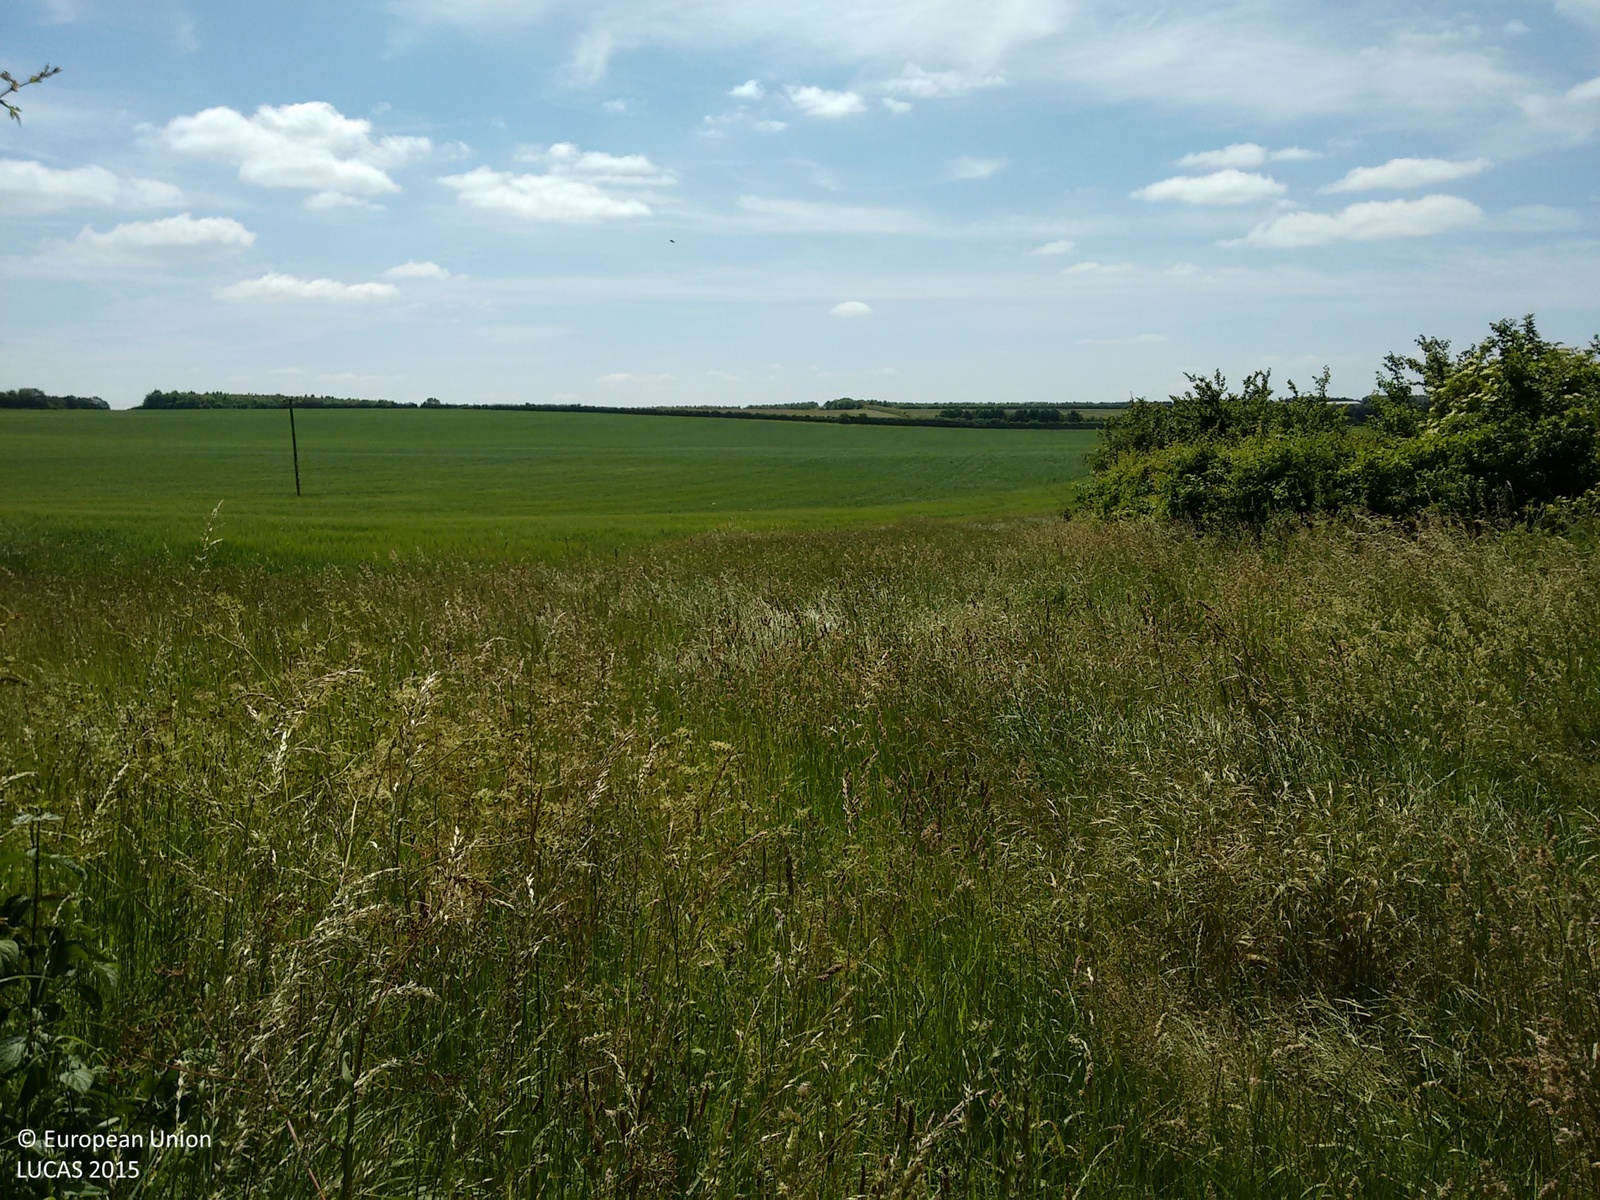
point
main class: Cropland
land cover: Barley
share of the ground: > 75 %
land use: Agriculture (excluding fallow land and kitchen gardens)
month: June
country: GB
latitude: 51.8923
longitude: -1.2805
